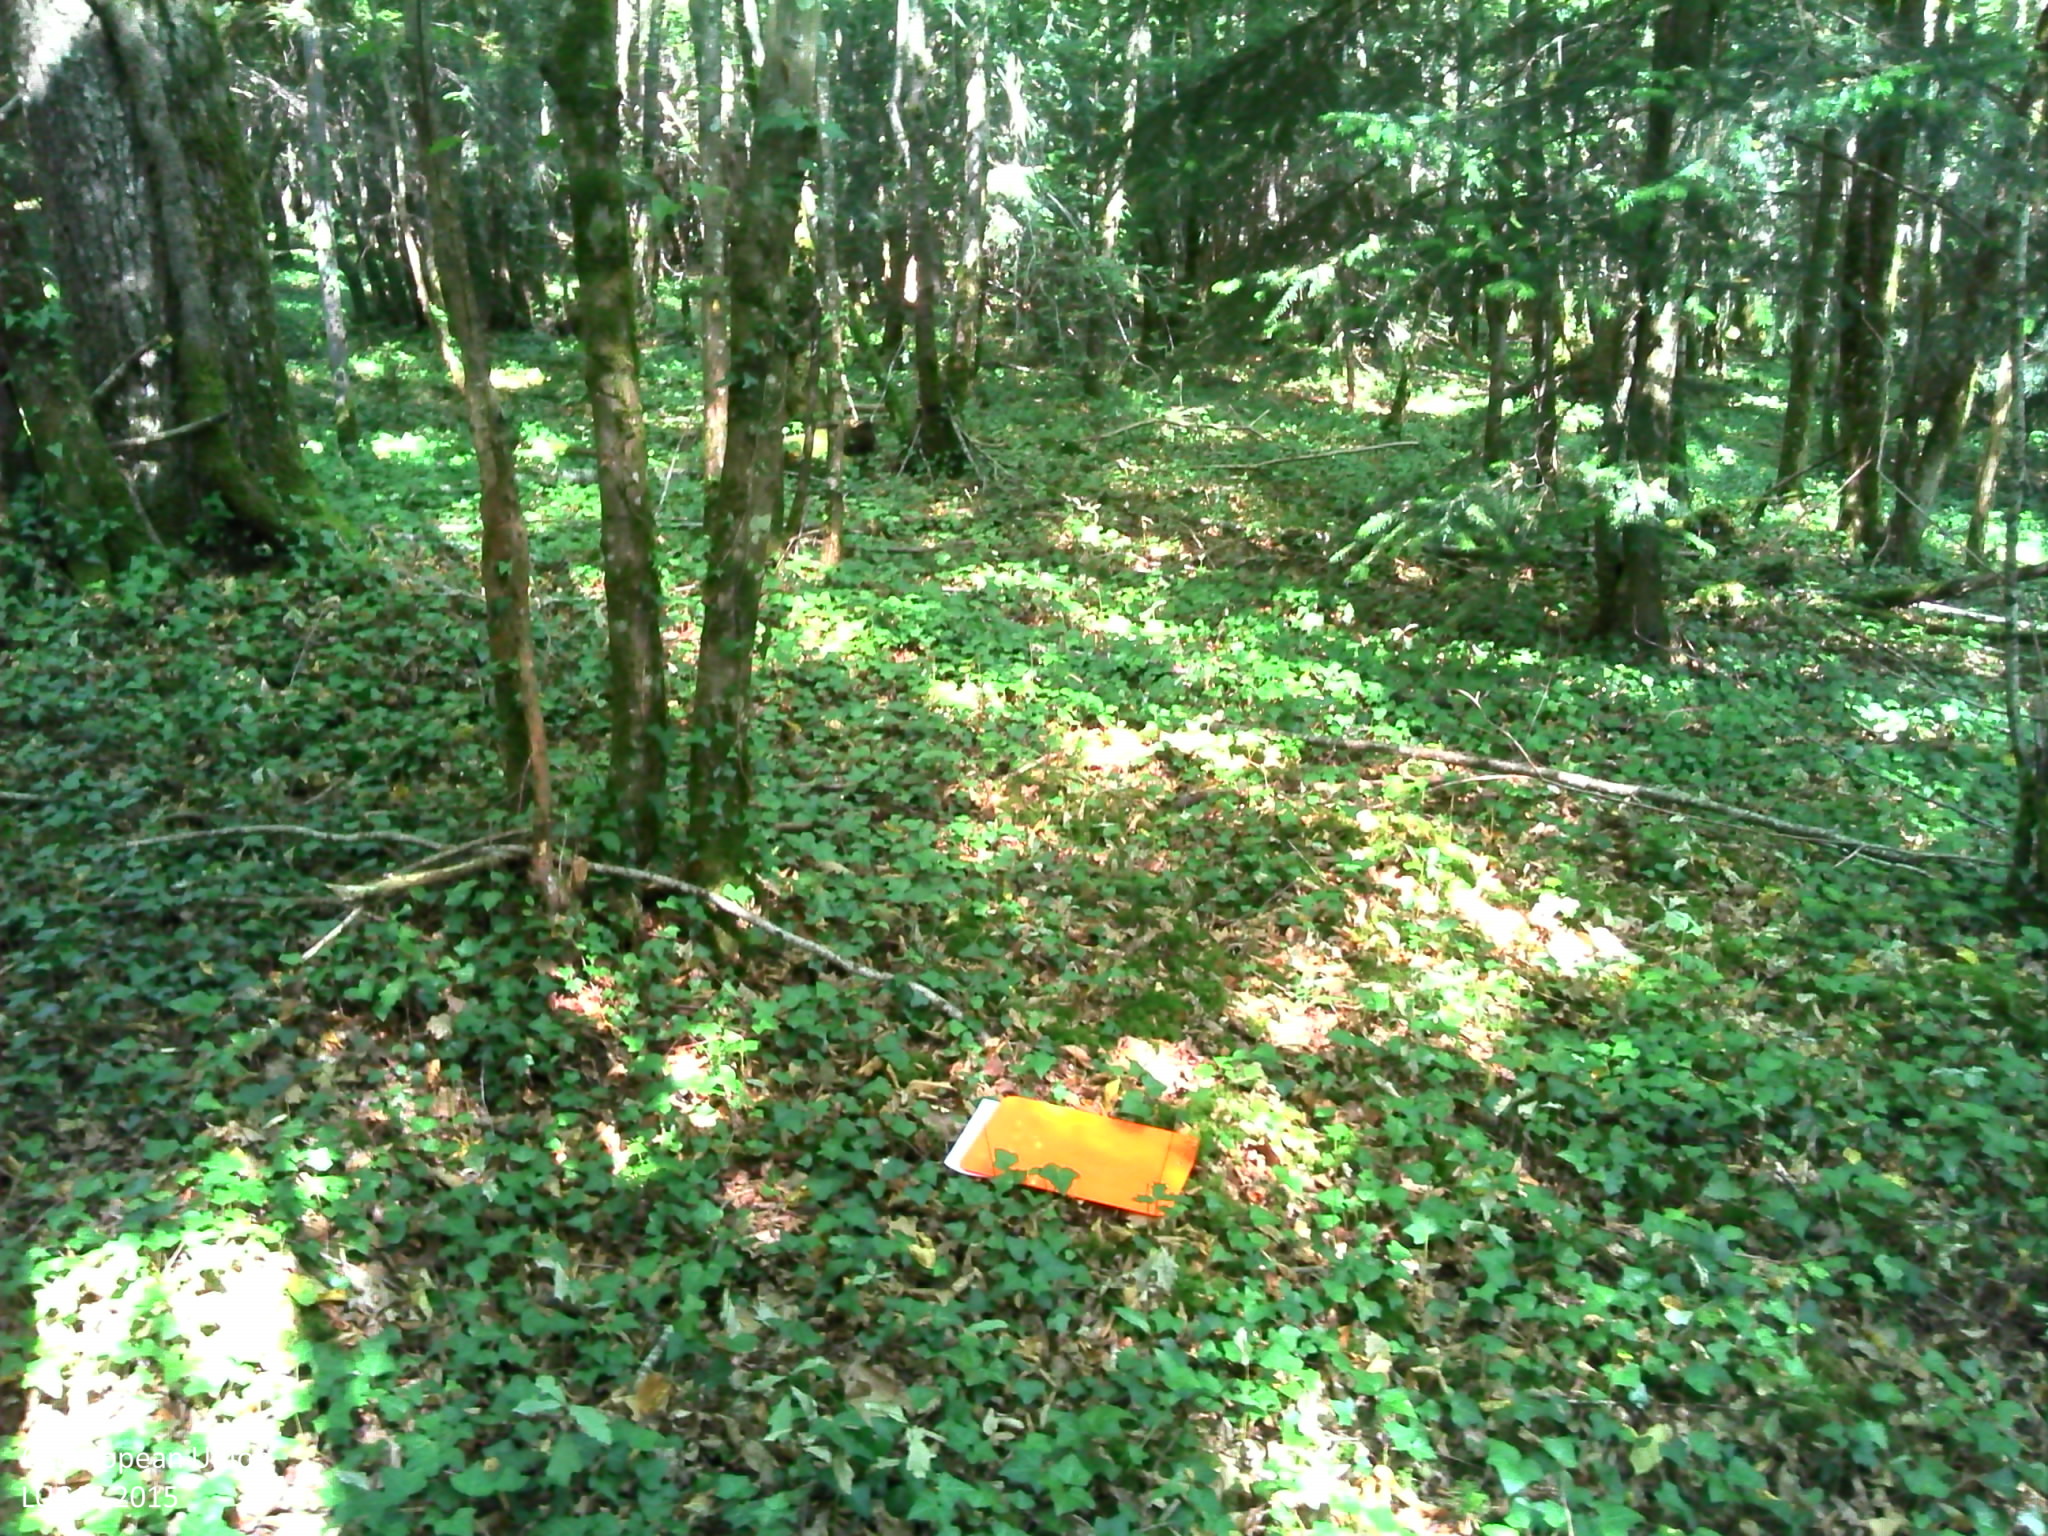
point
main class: Woodland
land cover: Pine dominated coniferous woodland
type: hemiboreal forest and nemoral coniferous forest and mixed broadleaved-coniferous forest
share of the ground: > 75 %
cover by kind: coniferous forest trees 80 %, herbaceous plants 10 %, shrubs 5 %, lichens and mosses 5 %
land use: Forestry
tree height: > 5 m
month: August
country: FR
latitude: 44.7716
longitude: 0.7557
